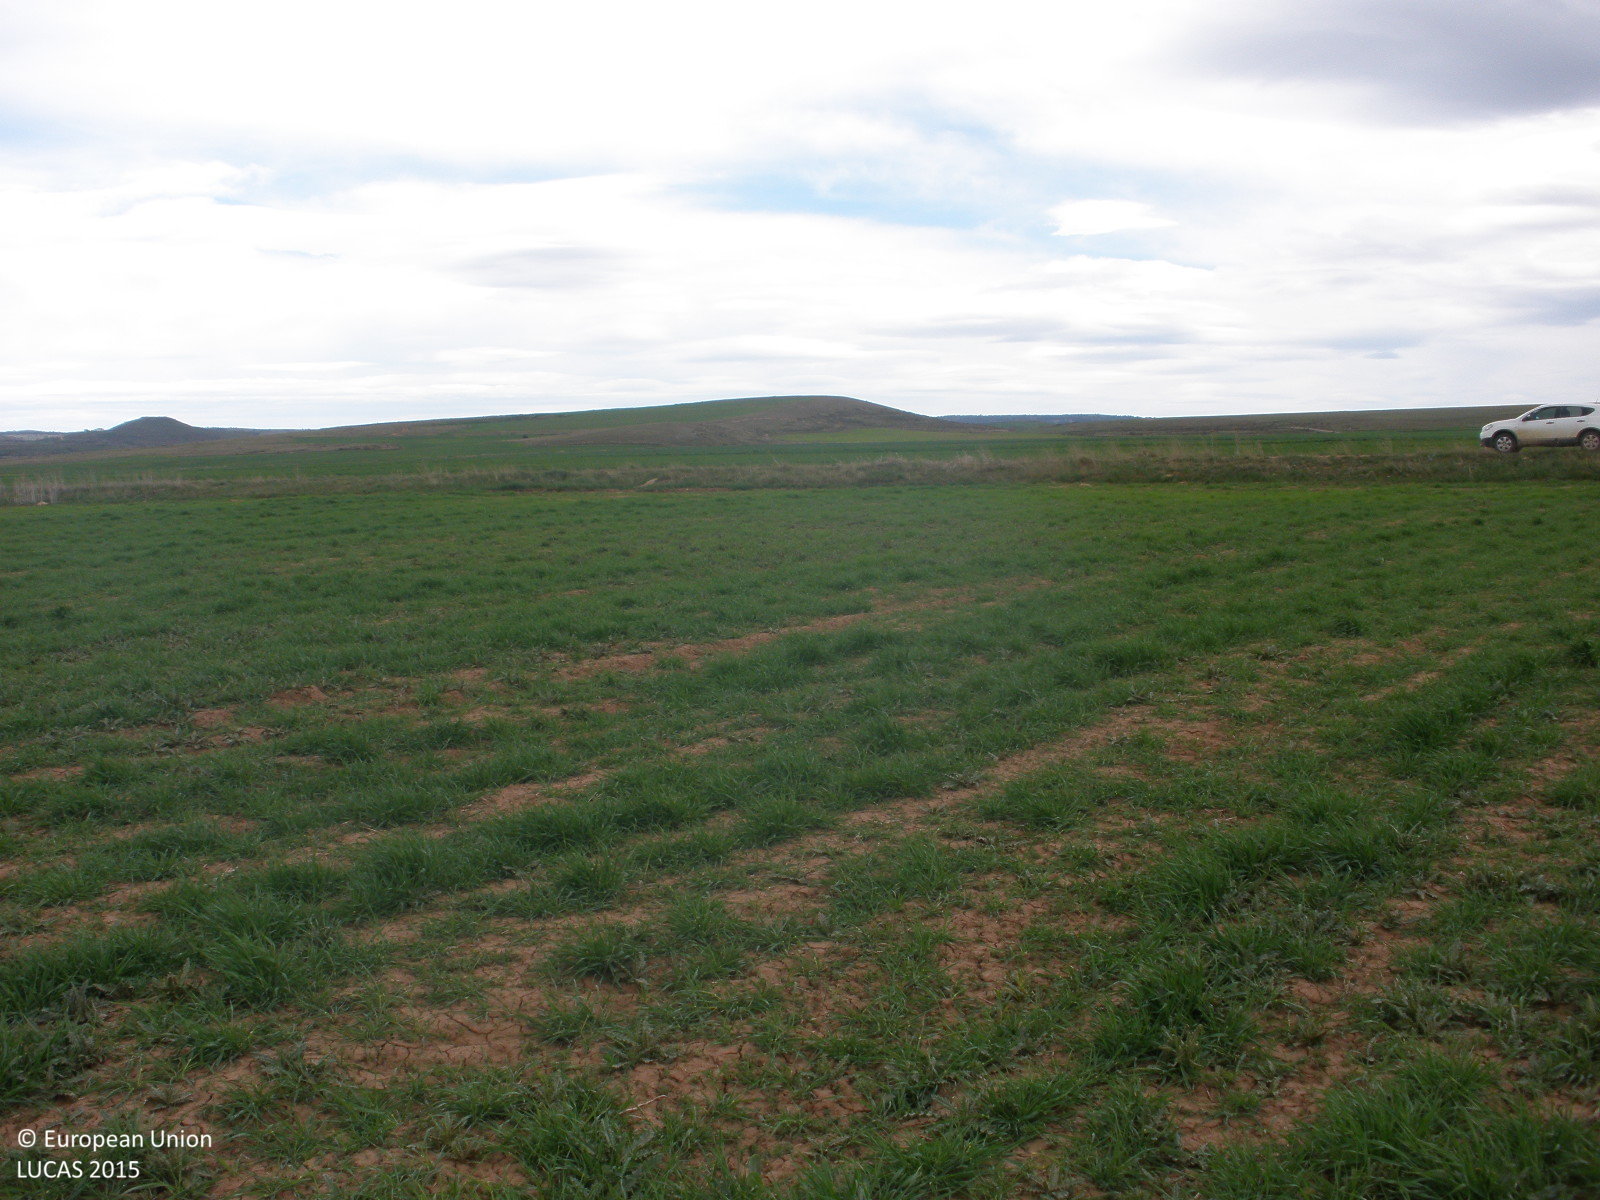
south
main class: Cropland
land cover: Barley
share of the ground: > 75 %
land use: Agriculture (excluding fallow land and kitchen gardens)
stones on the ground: < 10 %
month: May
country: ES
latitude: 40.4842
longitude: -0.8518
